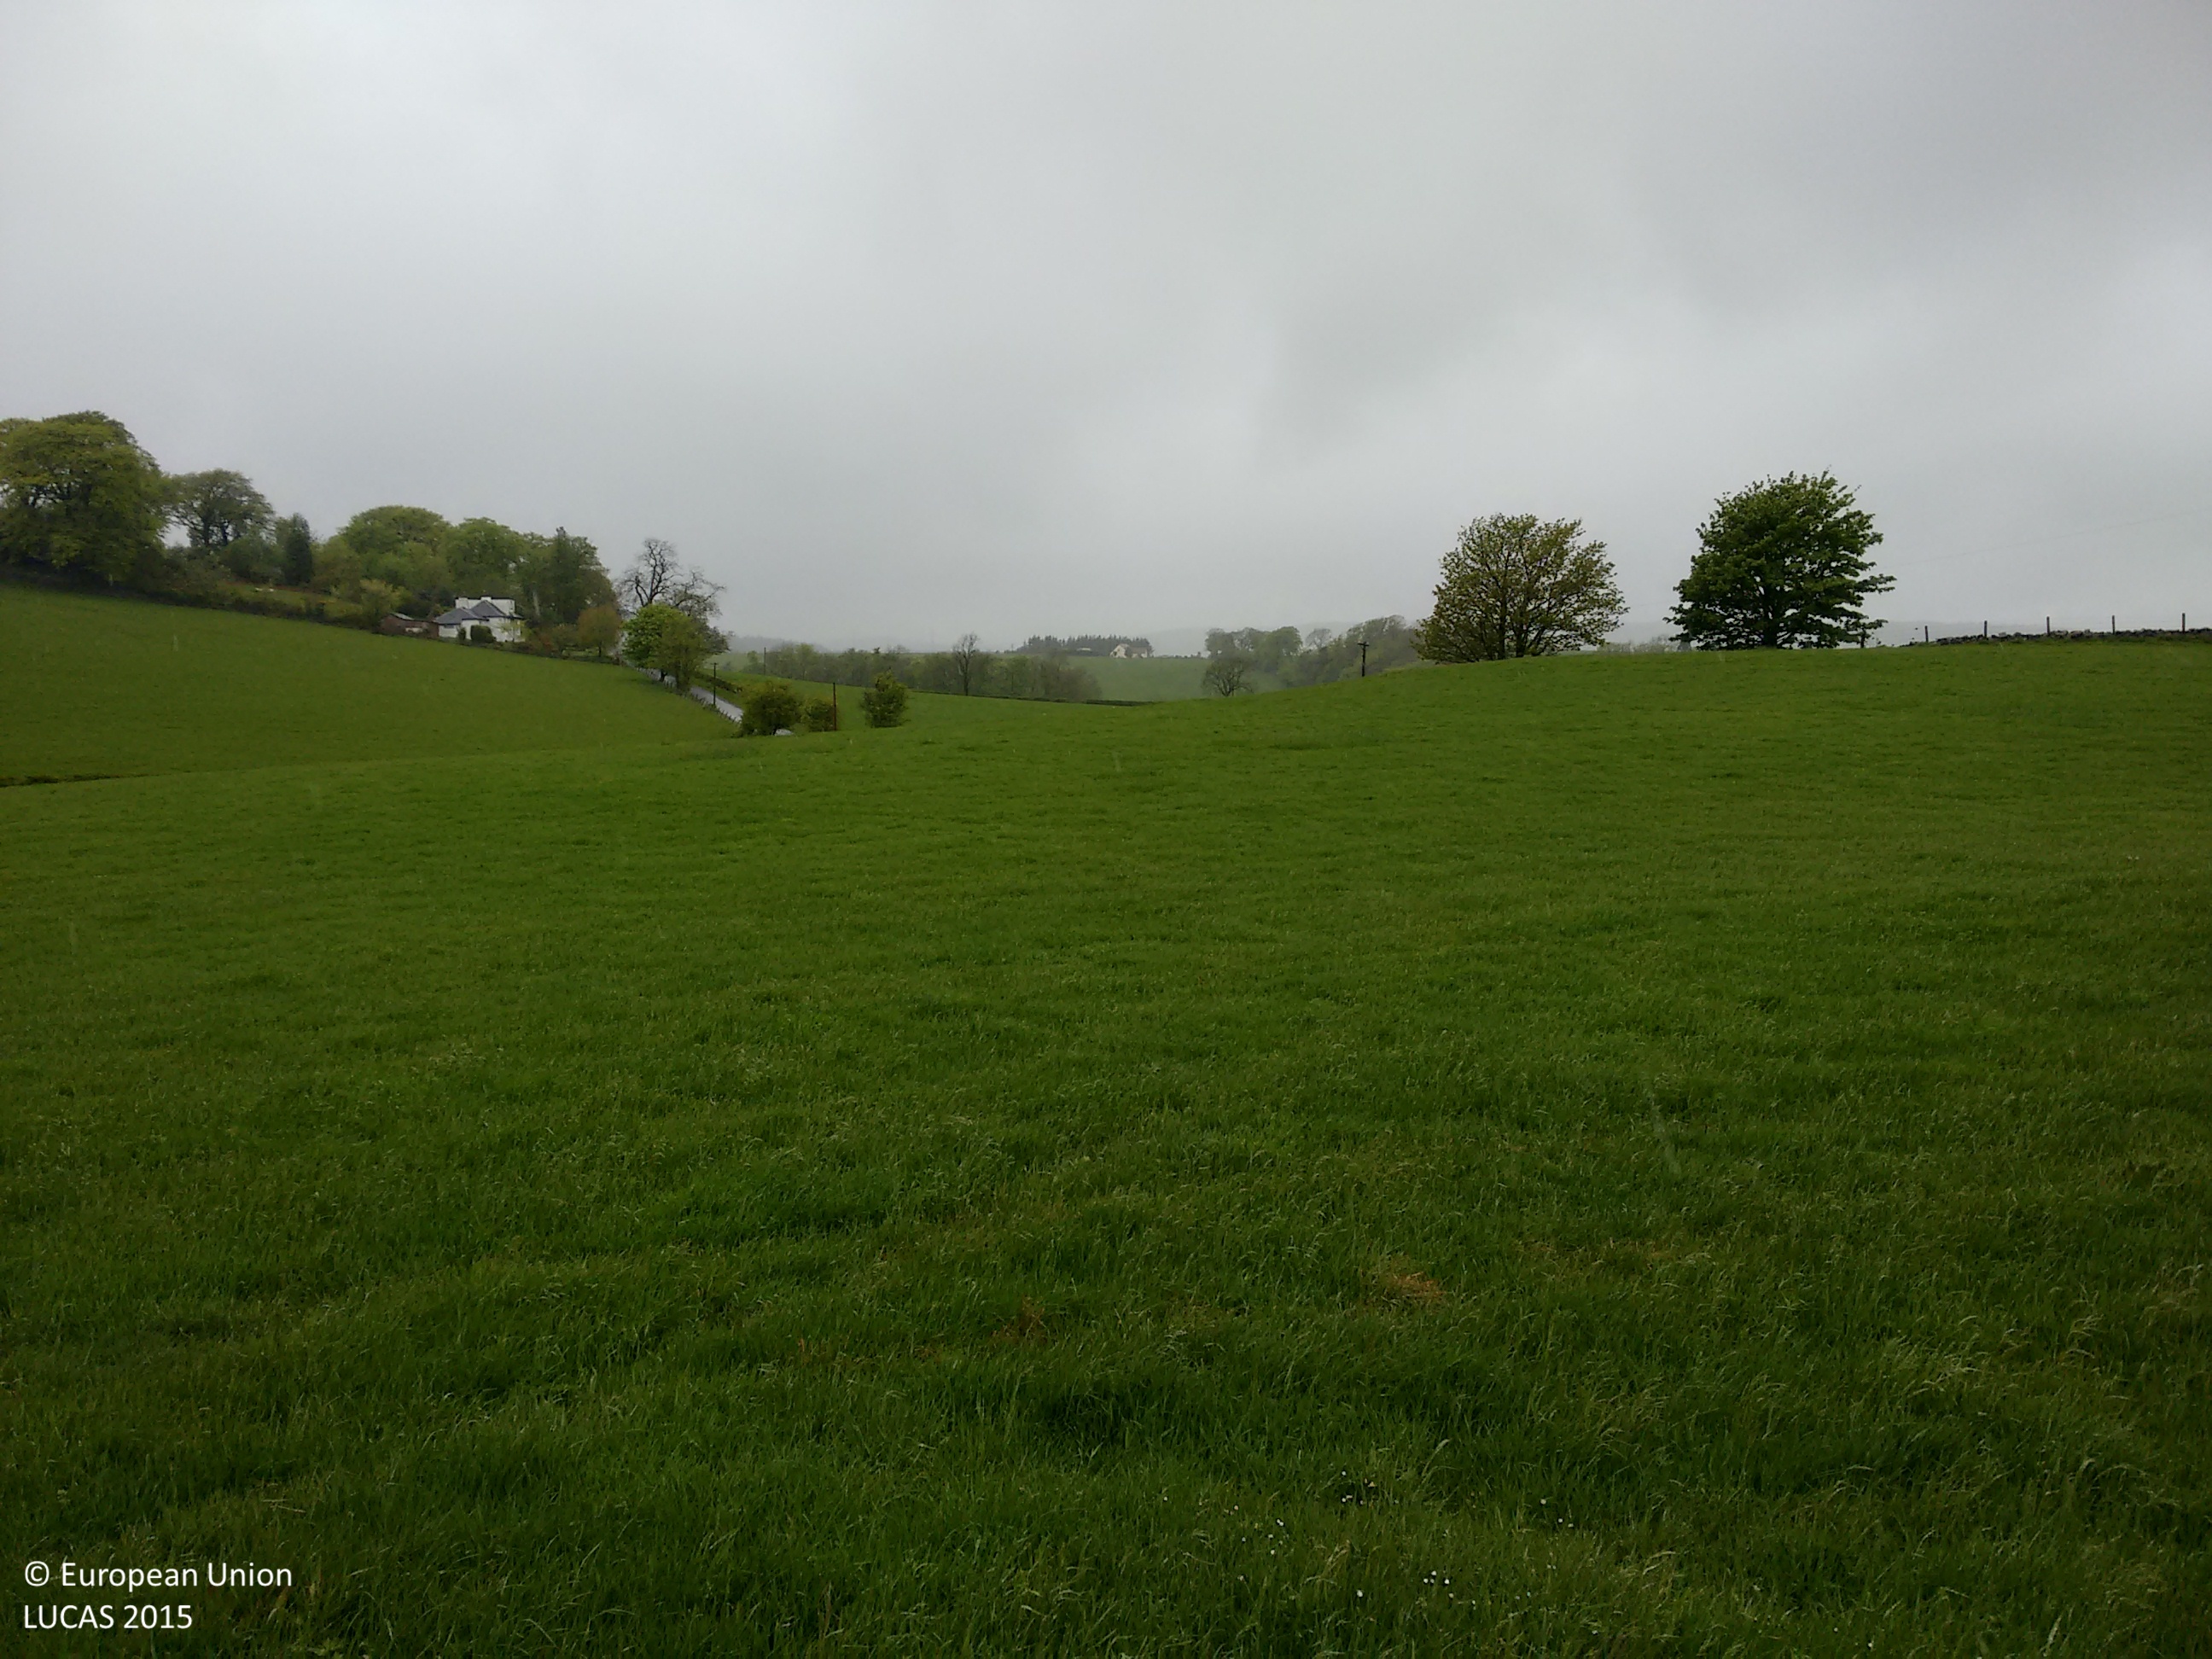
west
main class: Grassland
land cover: Grassland without tree/shrub cover
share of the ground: > 75 %
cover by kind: herbaceous plants 100 %
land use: Agriculture (excluding fallow land and kitchen gardens)
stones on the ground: < 10 %
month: May
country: GB
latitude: 55.7761
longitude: -4.3646
